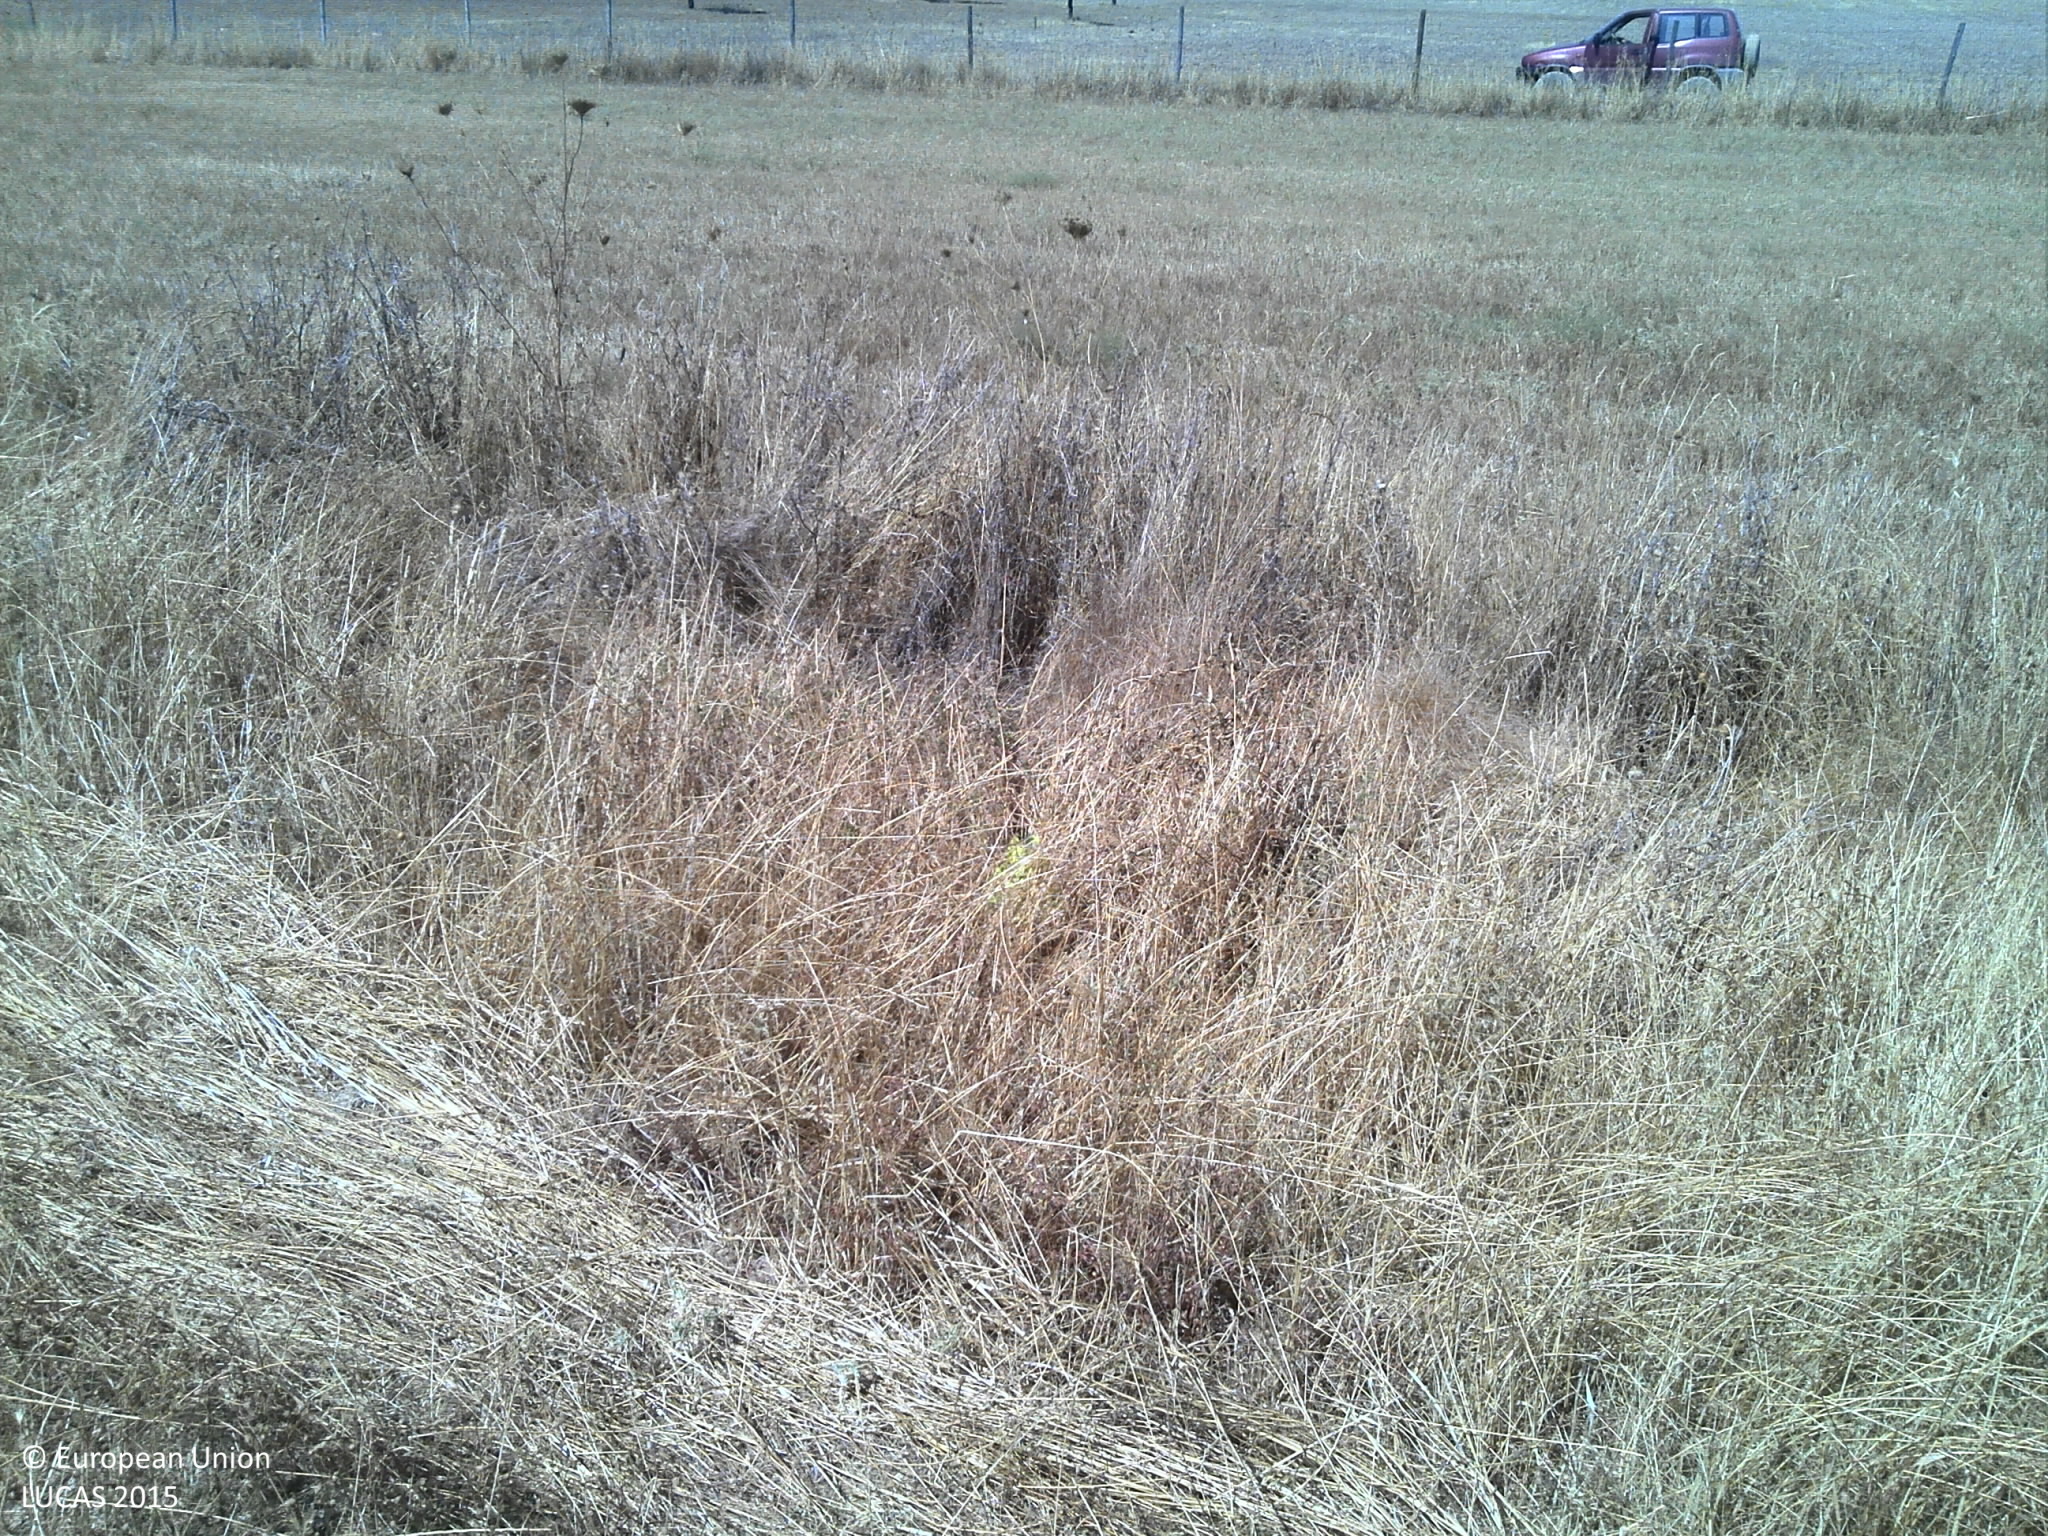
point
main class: Cropland
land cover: Oats
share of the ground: < 10 %
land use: Agriculture (excluding fallow land and kitchen gardens)
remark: Harvested field
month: July
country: PT
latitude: 38.5358
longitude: -7.3838
